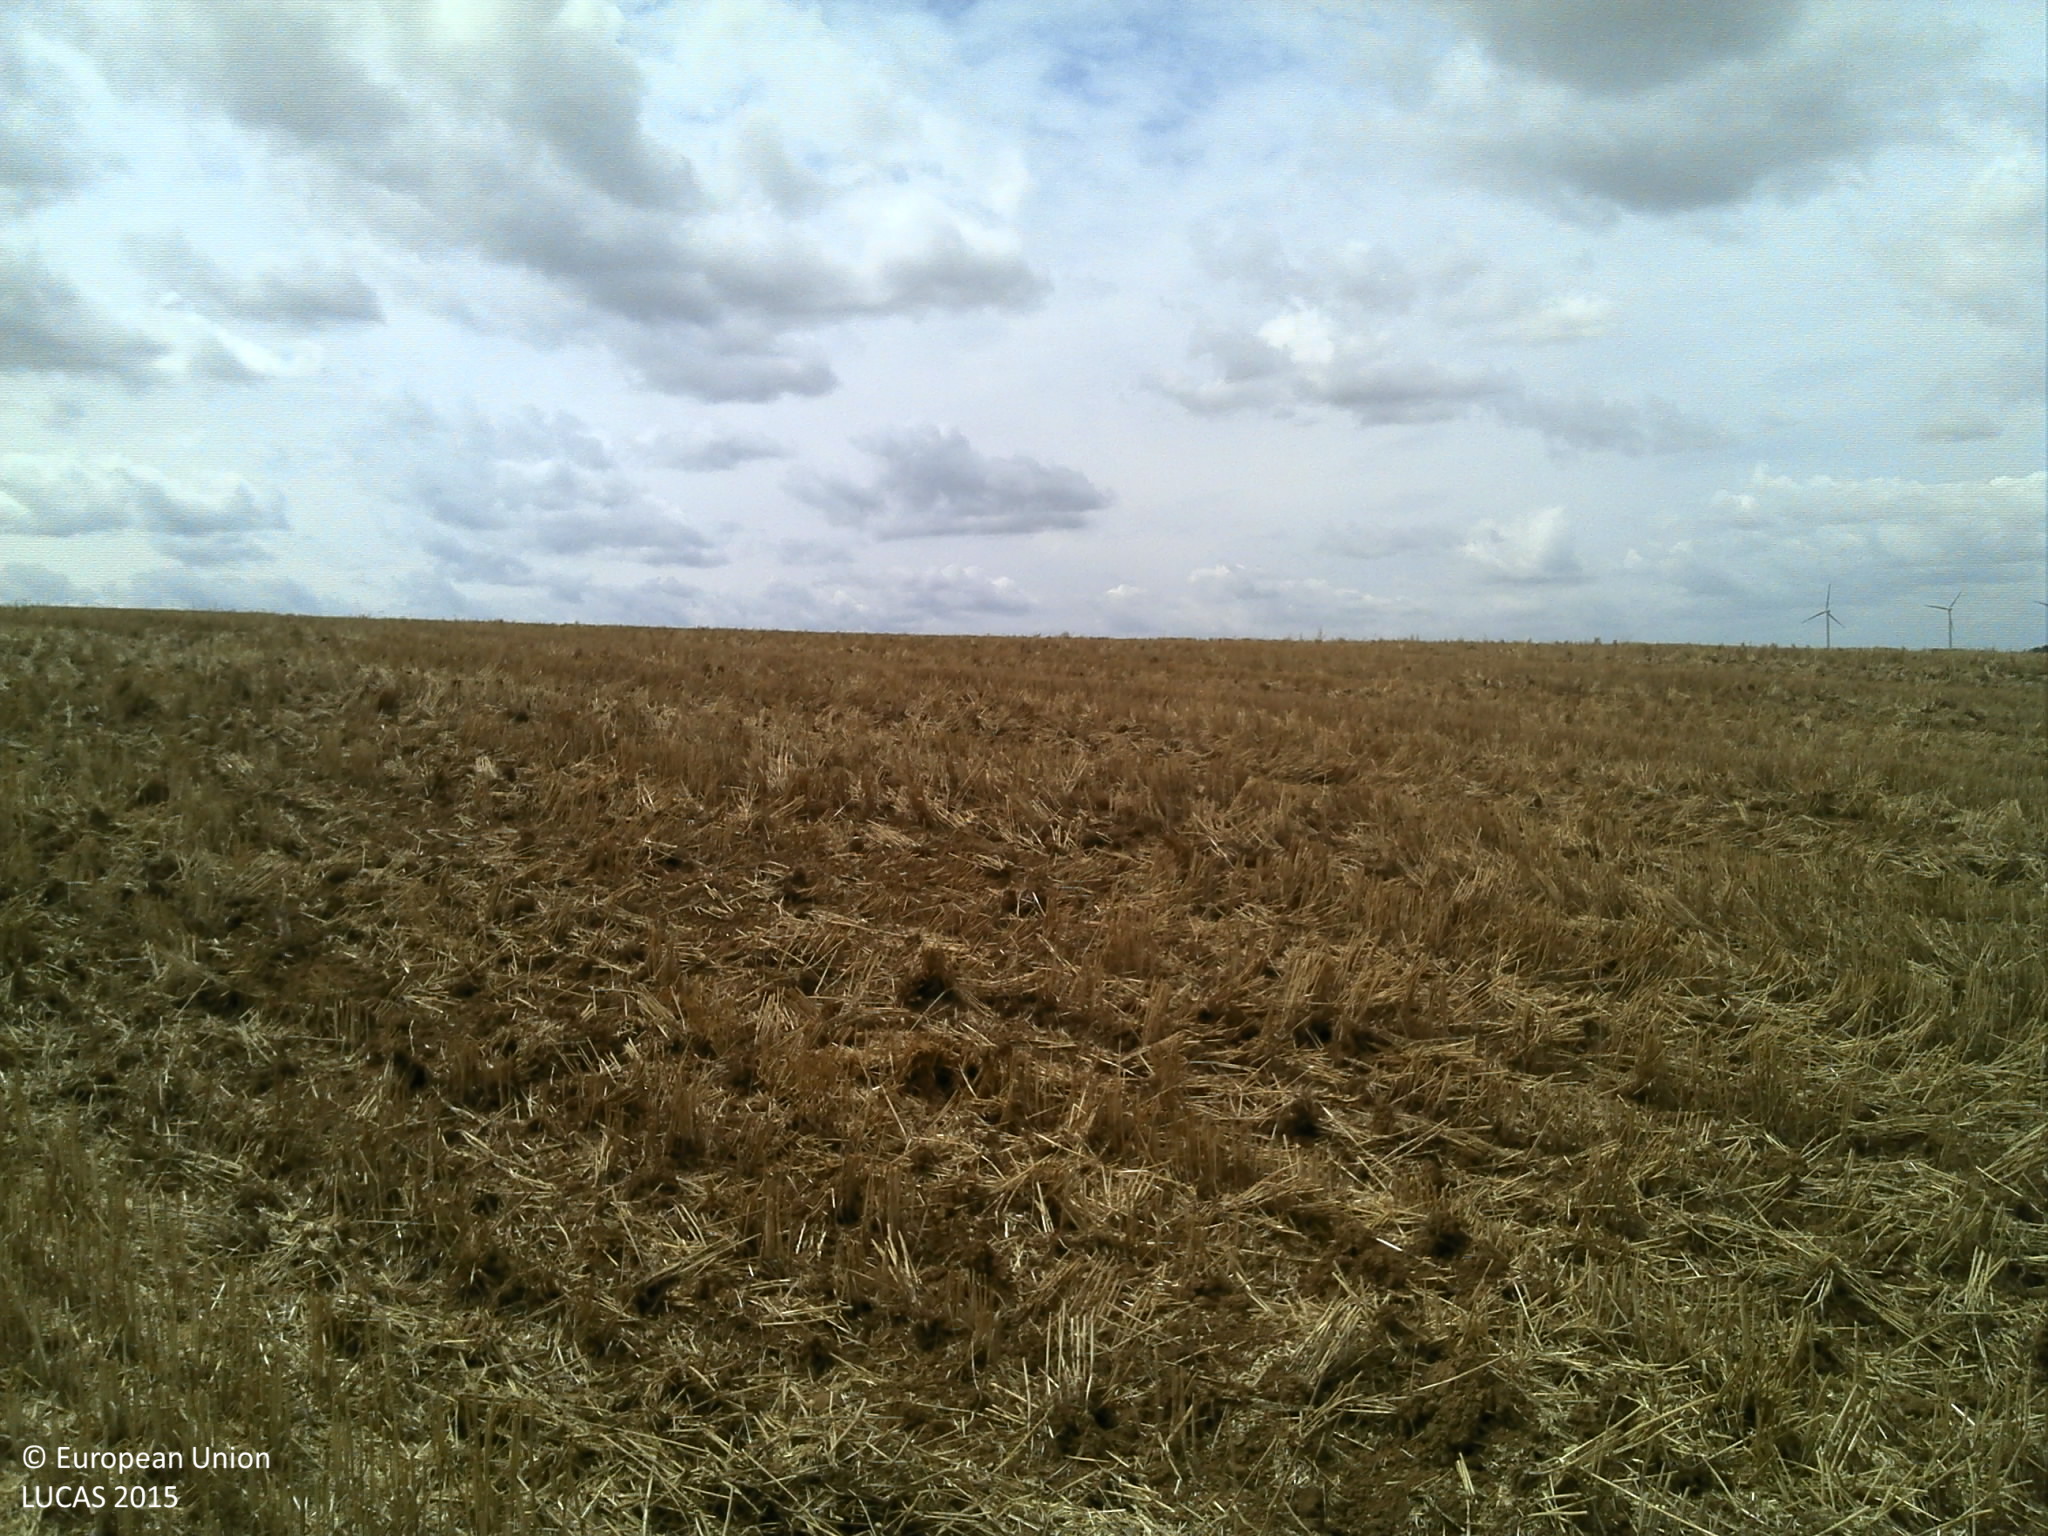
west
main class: Cropland
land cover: Common wheat
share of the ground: 50 - 75 %
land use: Agriculture (excluding fallow land and kitchen gardens)
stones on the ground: < 10 %
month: July
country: FR
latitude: 49.6174
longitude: 4.1125
